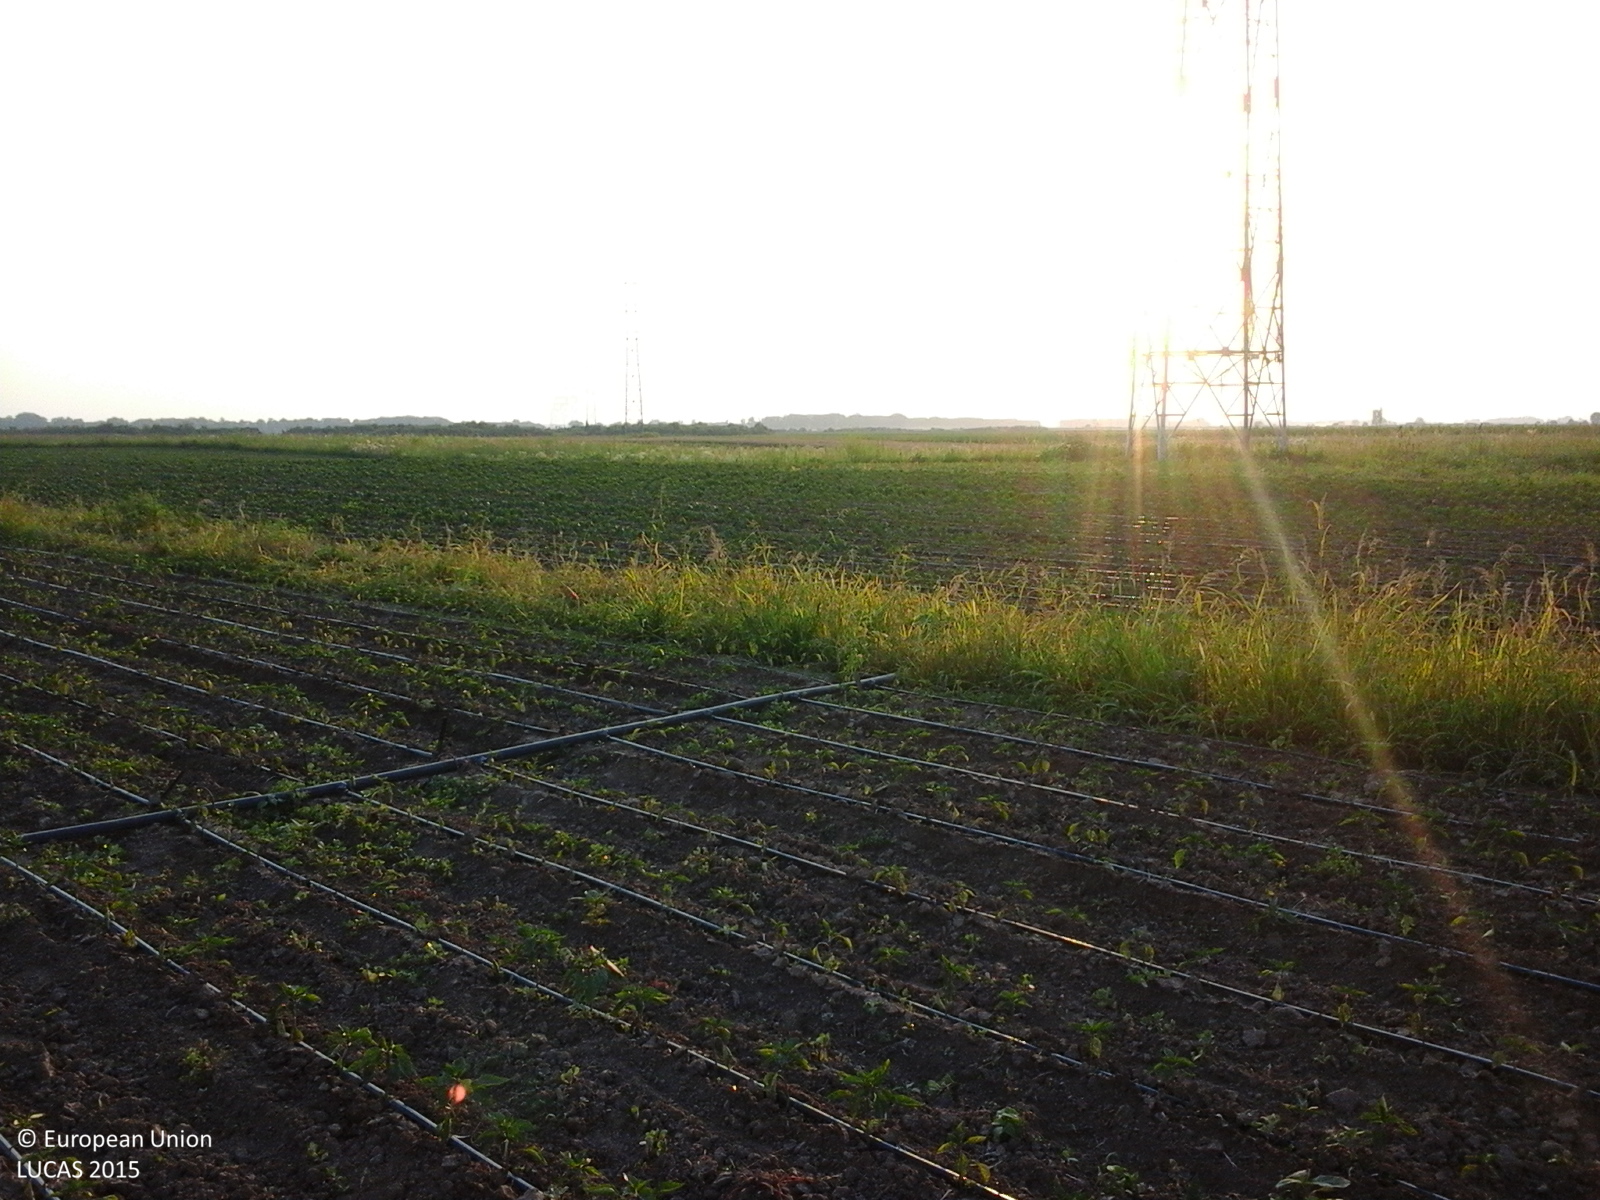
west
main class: Cropland
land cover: Other fresh vegetables
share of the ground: 10 - 25 %
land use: Agriculture (excluding fallow land and kitchen gardens)
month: July
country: RO
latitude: 44.8348
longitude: 25.6964
